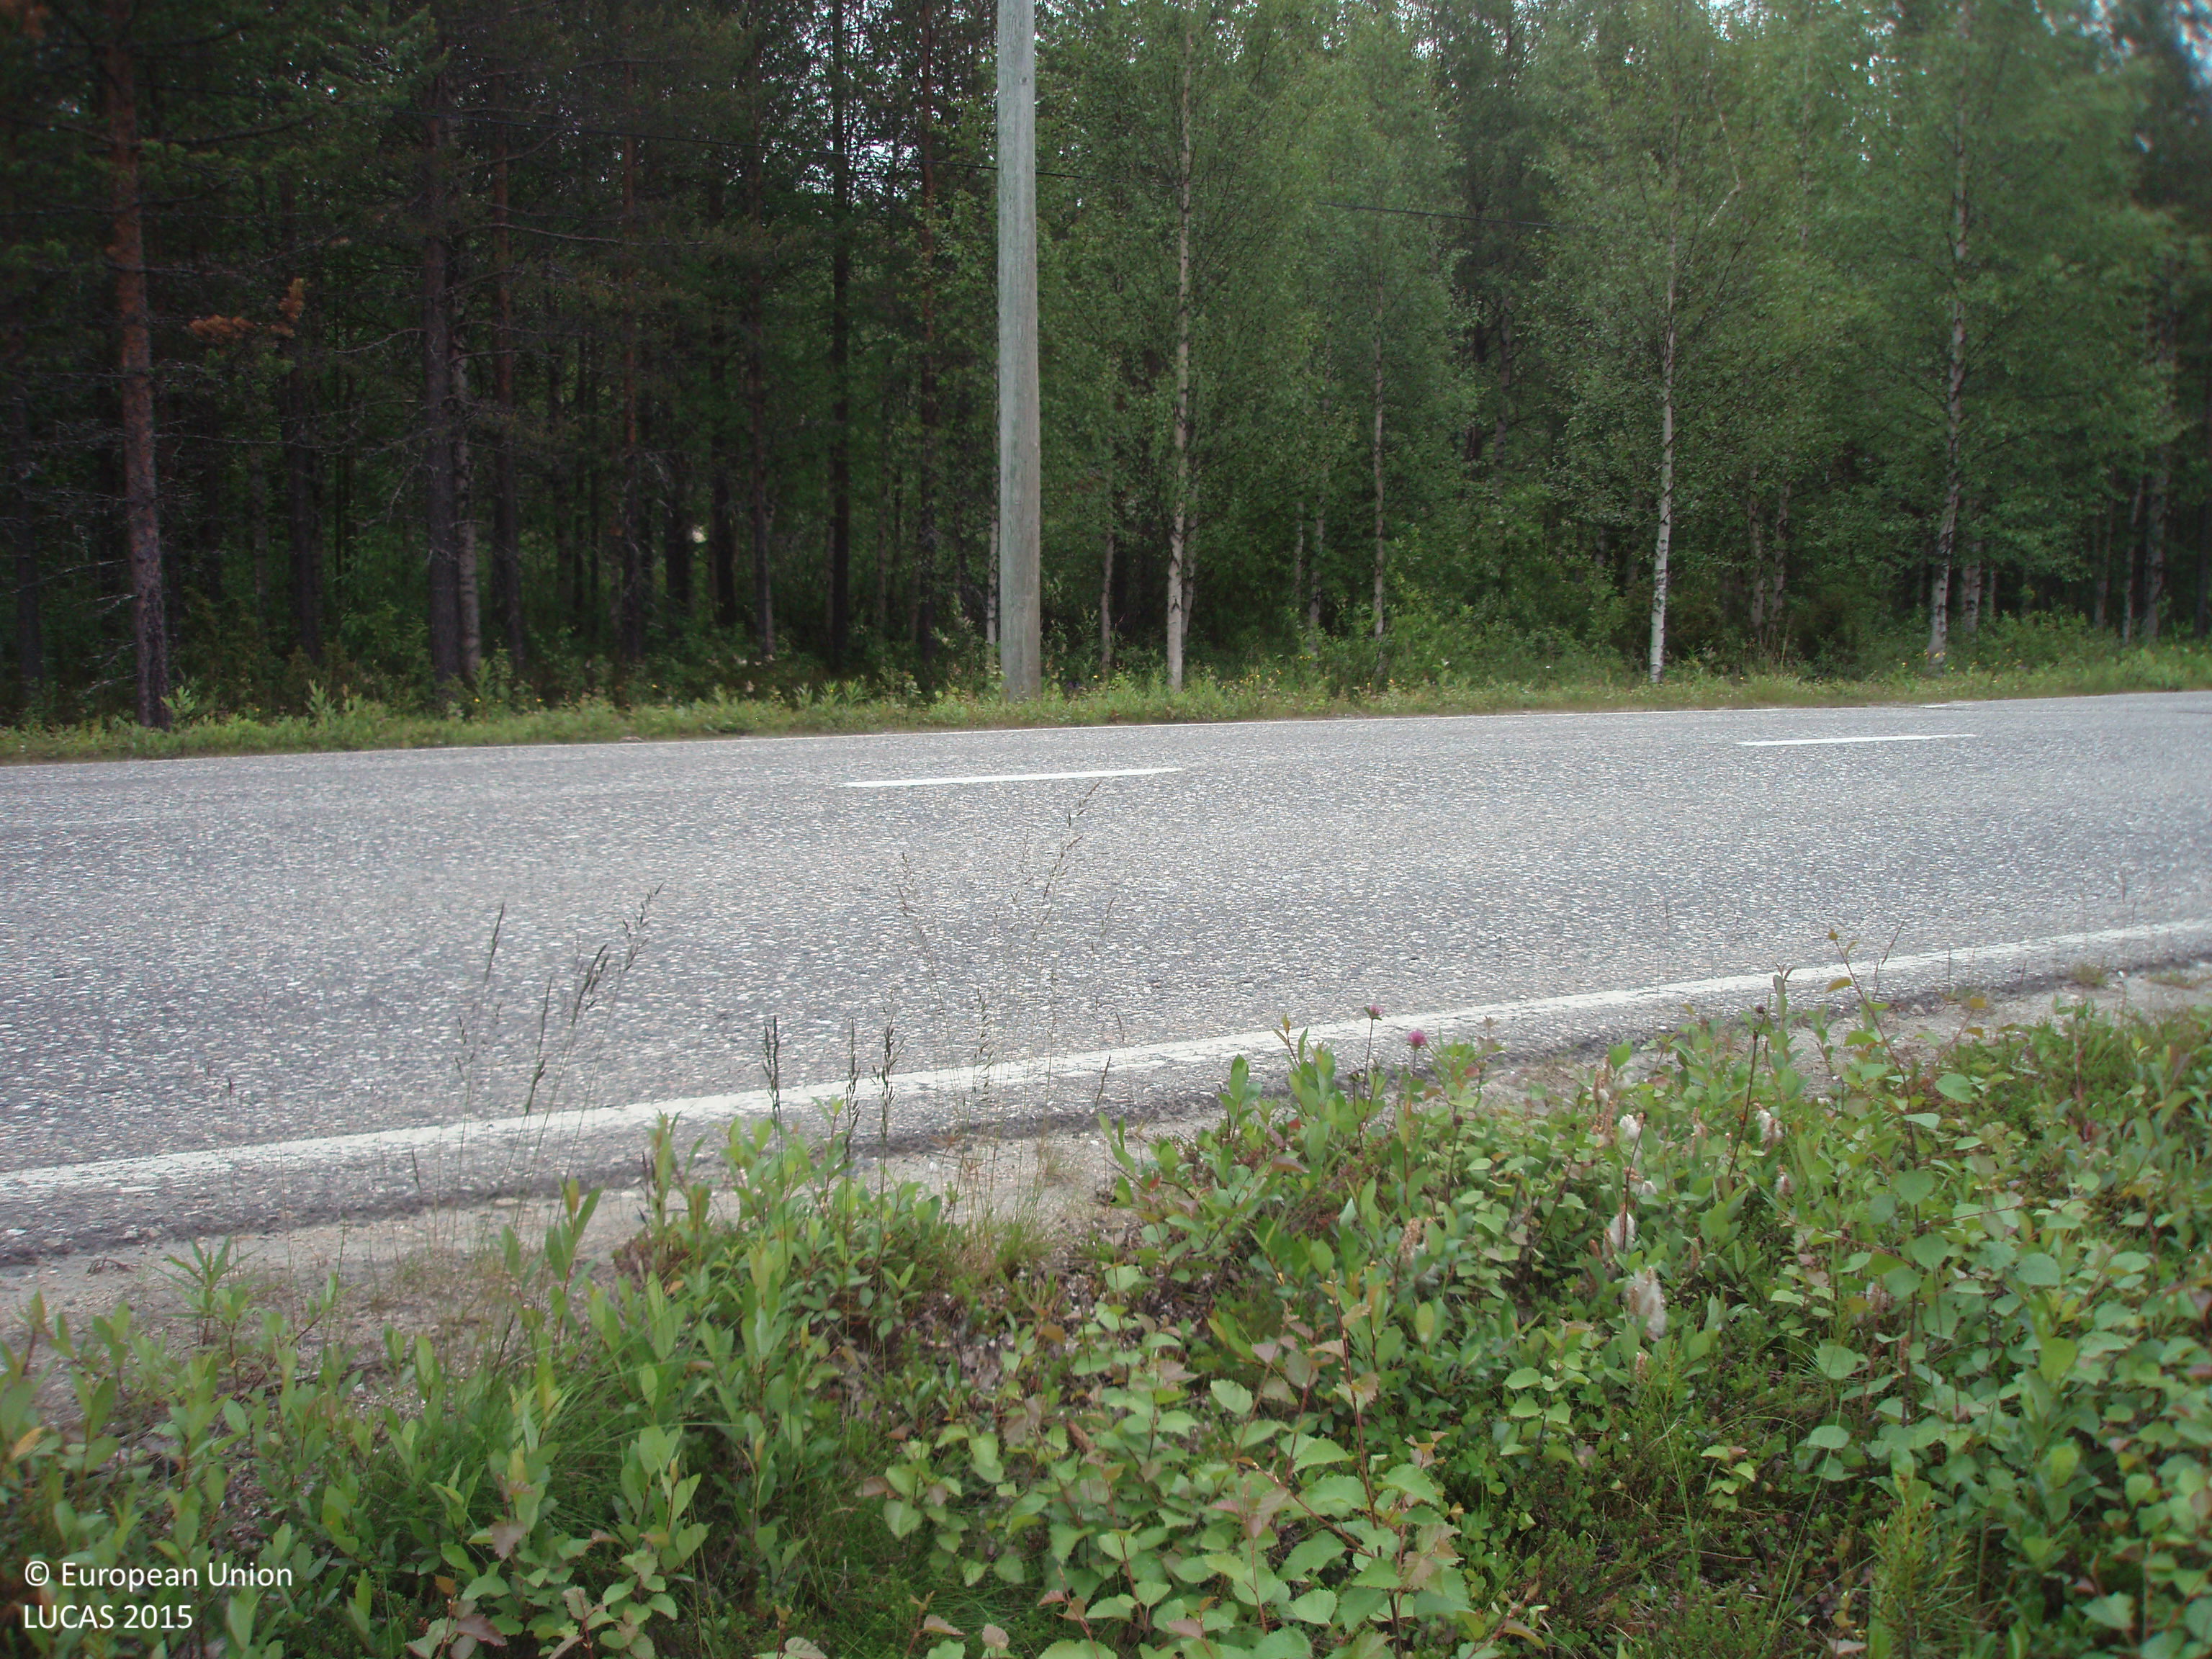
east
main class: Shrubland
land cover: Shrubland with sparse tree cover
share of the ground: > 75 %
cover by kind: shrubs 95 %, broadleaved forest trees 5 %
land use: Road transport
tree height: < 5 m
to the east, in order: Shrubland with sparse tree cover; Paved roads, cycling and walking lanes; Shruby margins; Electric lines; Ditches and canals; Electric lines; Pine dominated mixed woodland; Electric lines; Pine dominated mixed woodland; Tracks; Pine dominated mixed woodland; Artificial constructions in urban areas
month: July
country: FI
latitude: 67.2982
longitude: 28.1626
